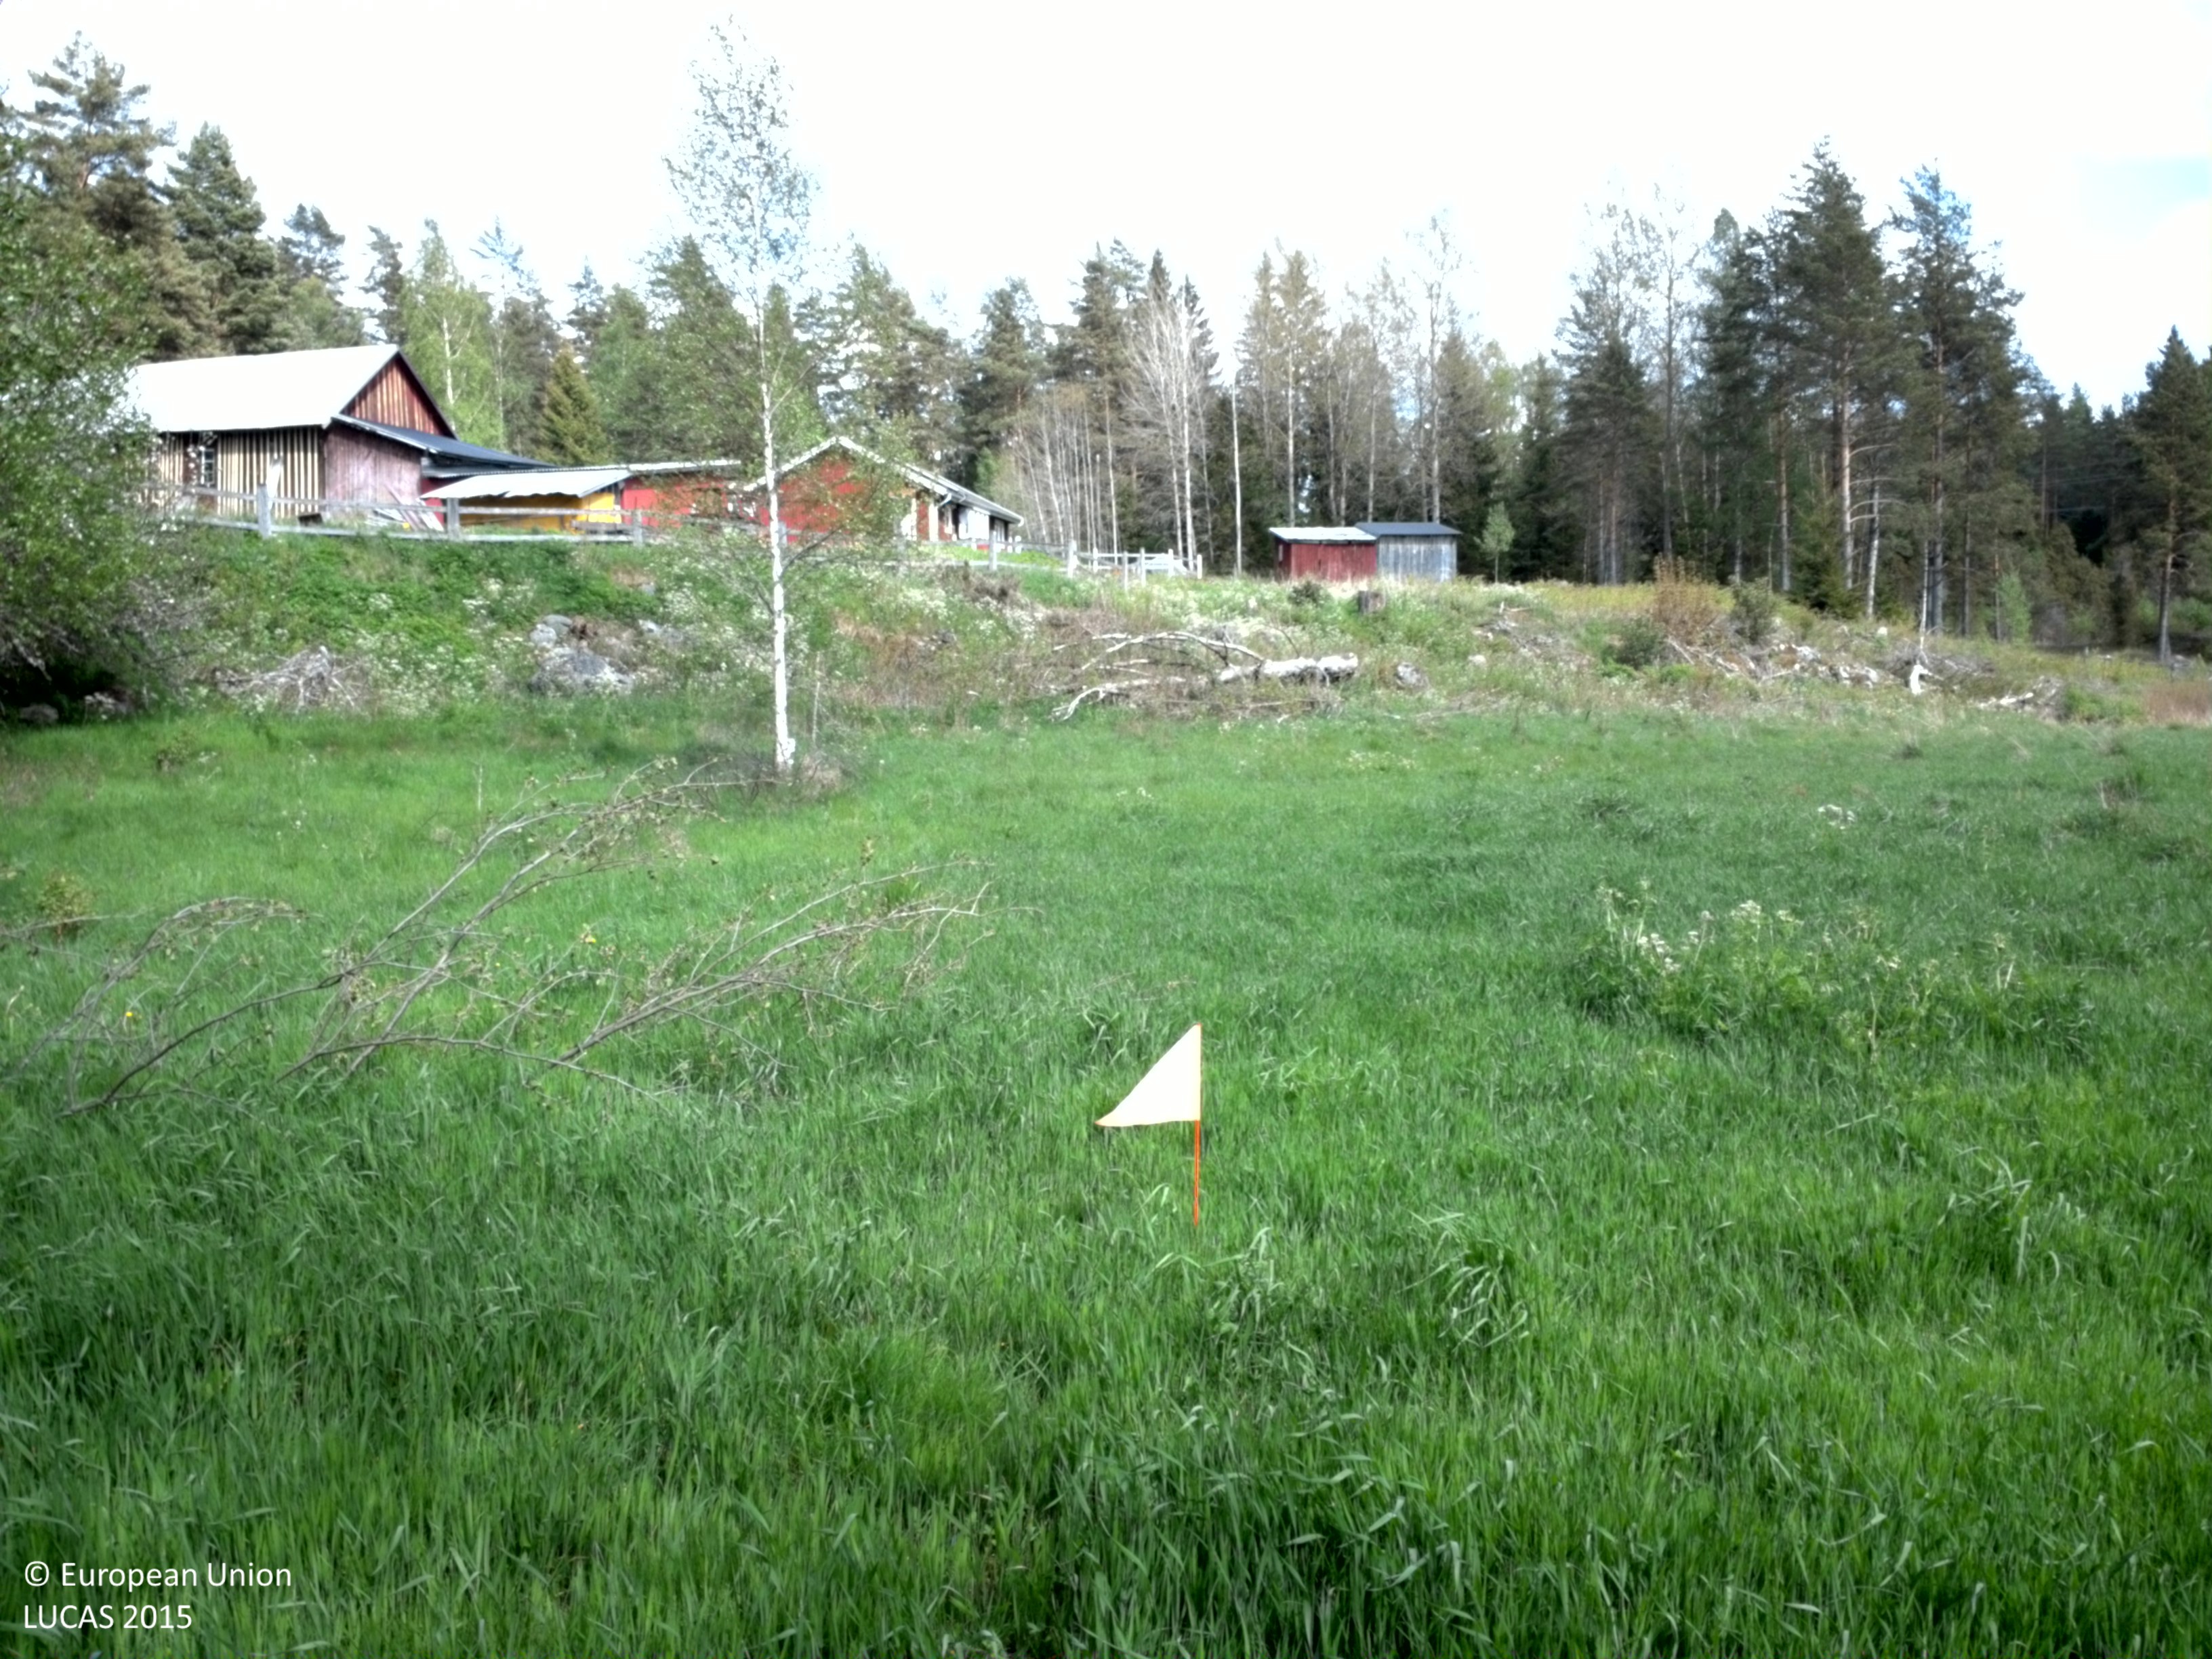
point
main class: Grassland
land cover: Grassland with sparse tree/shrub cover
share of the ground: > 75 %
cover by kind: herbaceous plants 95 %, coniferous forest trees 5 %
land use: Agriculture (excluding fallow land and kitchen gardens)
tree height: > 5 m
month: May
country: SE
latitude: 57.4049
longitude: 15.4728
